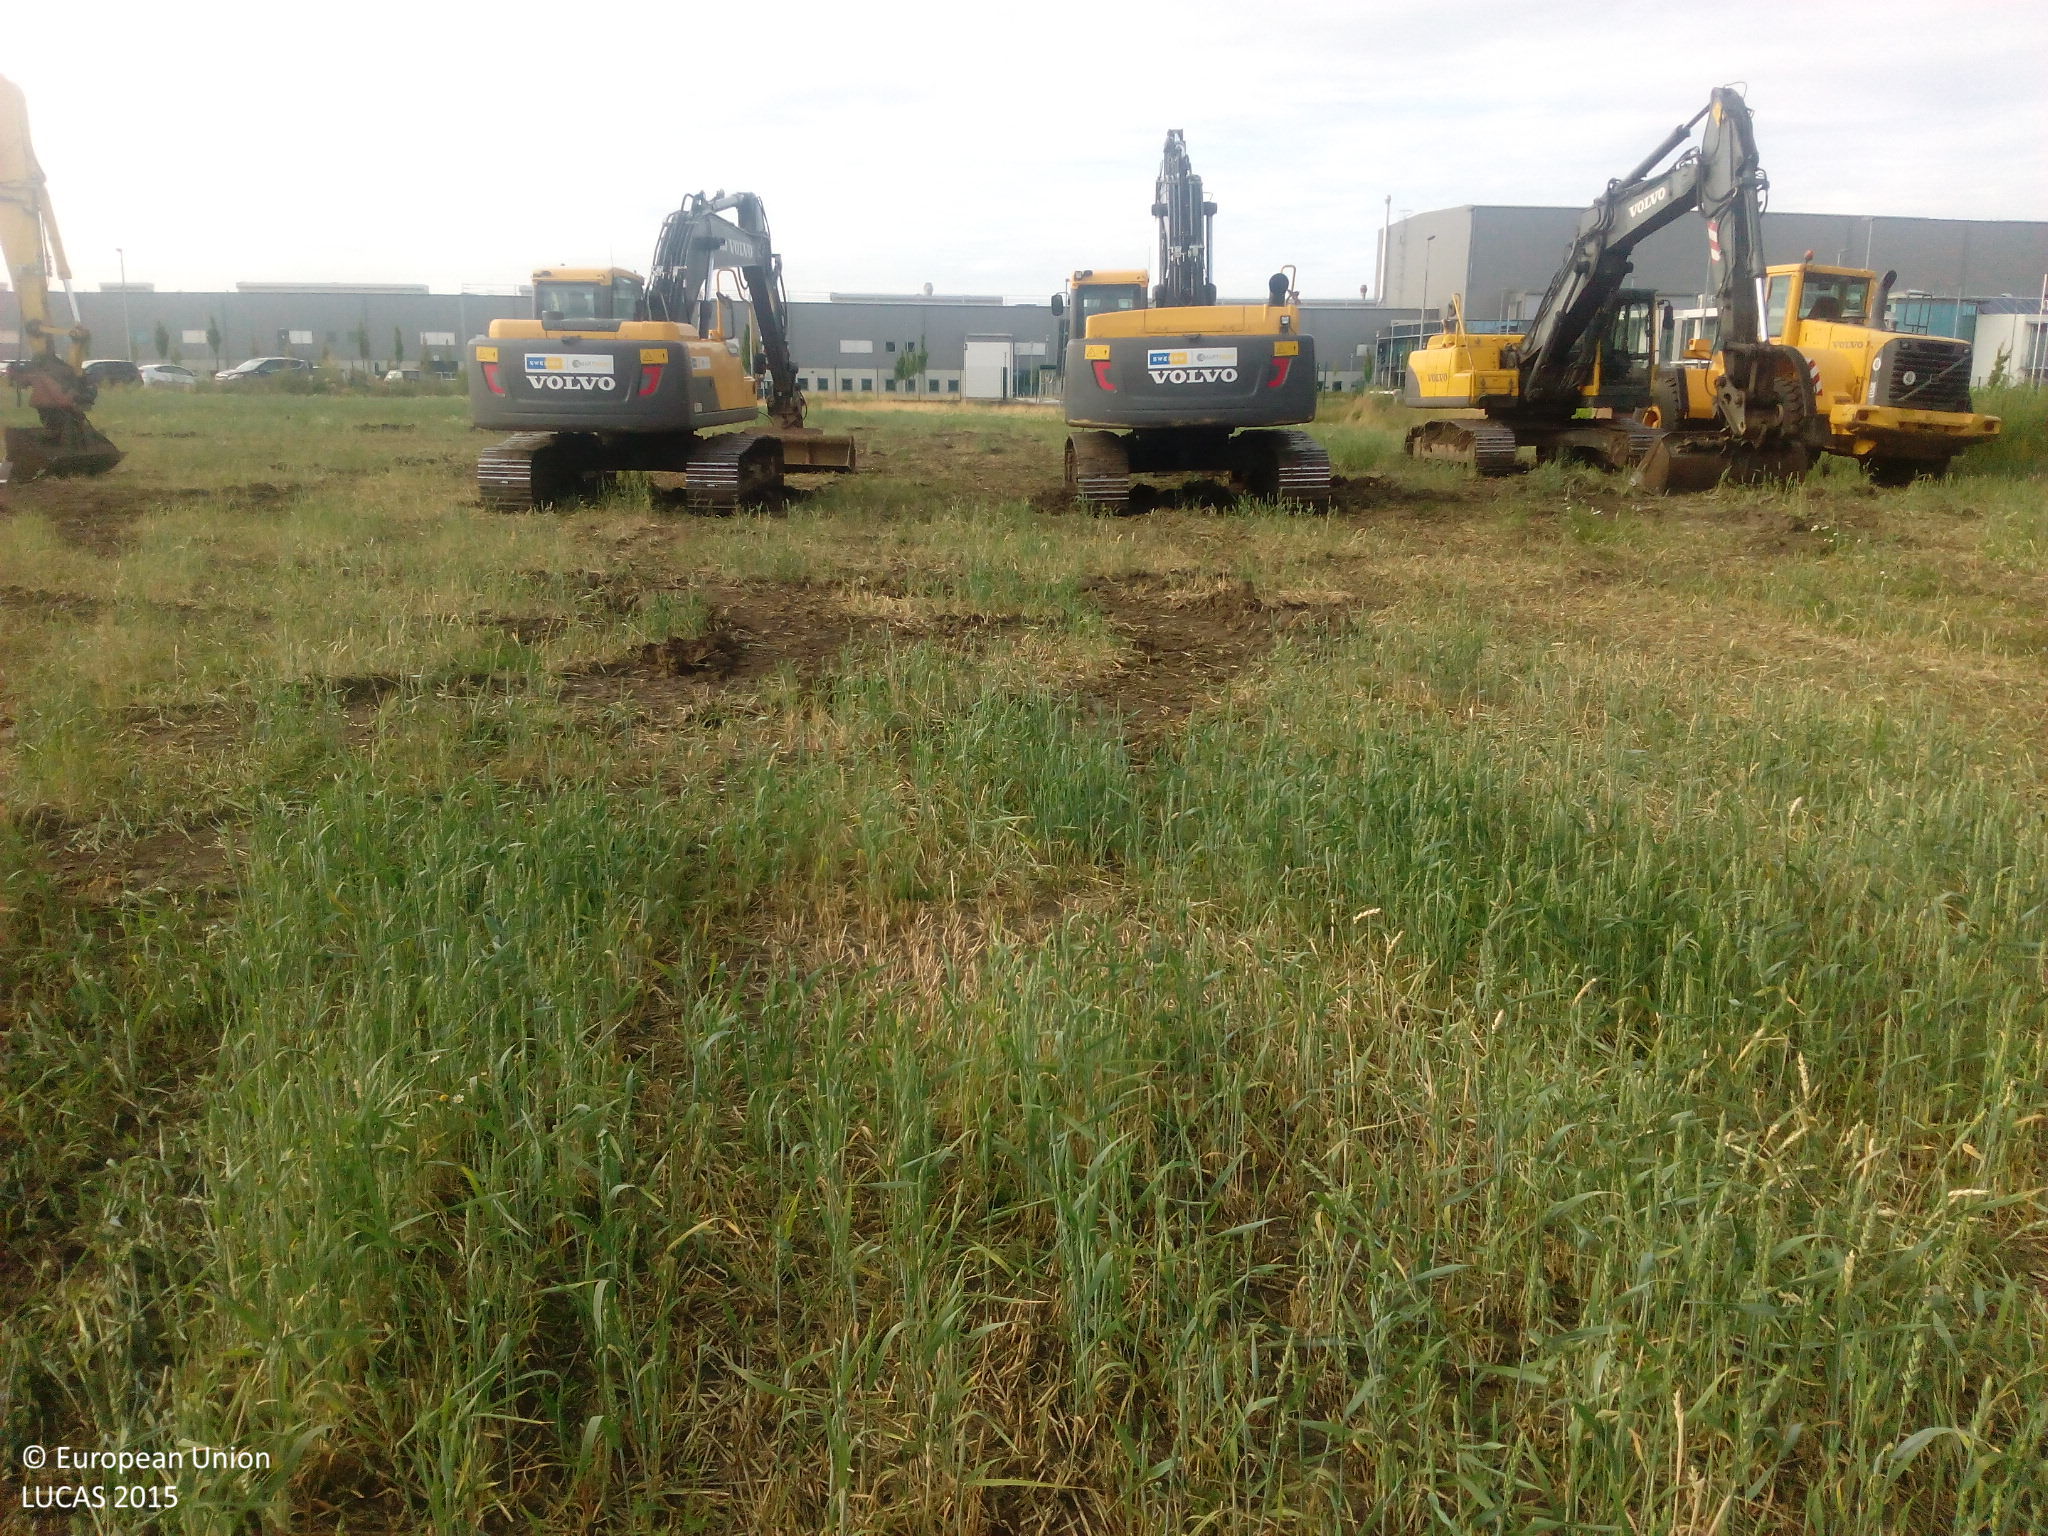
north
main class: Cropland
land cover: Common wheat
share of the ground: 25 - 50 %
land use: Agriculture (excluding fallow land and kitchen gardens)
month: July
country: DE
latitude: 52.0616
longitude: 11.5603
